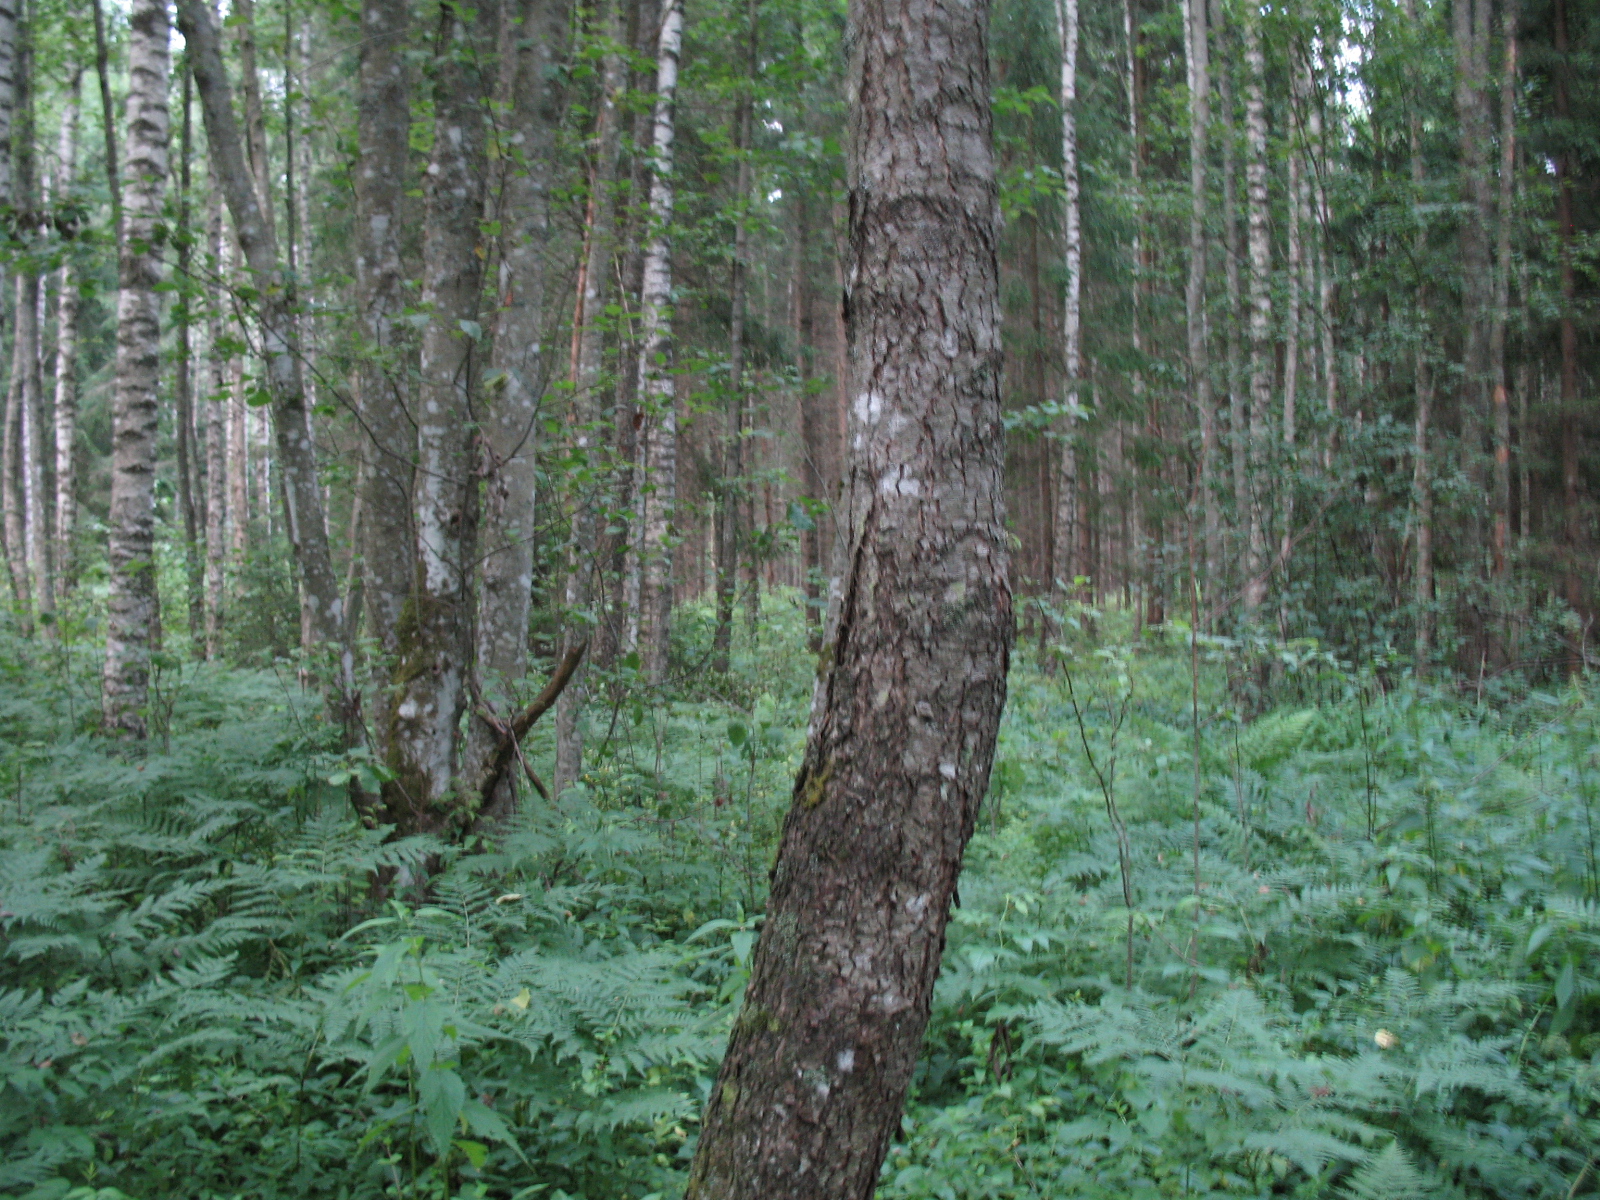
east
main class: Woodland
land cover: Broadleaved woodland
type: non-riverine alder, birch or aspen forest
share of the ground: > 75 %
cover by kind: broadleaved forest trees 80 %, herbaceous plants 10 %, coniferous forest trees 5 %, shrubs 5 %
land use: Forestry
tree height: > 5 m
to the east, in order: Broadleaved woodland; Spruce dominated mixed woodland; Spruce dominated coniferous woodland; Spruce dominated mixed woodland; Other coniferous woodland
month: July
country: LV
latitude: 56.4126
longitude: 25.0365
